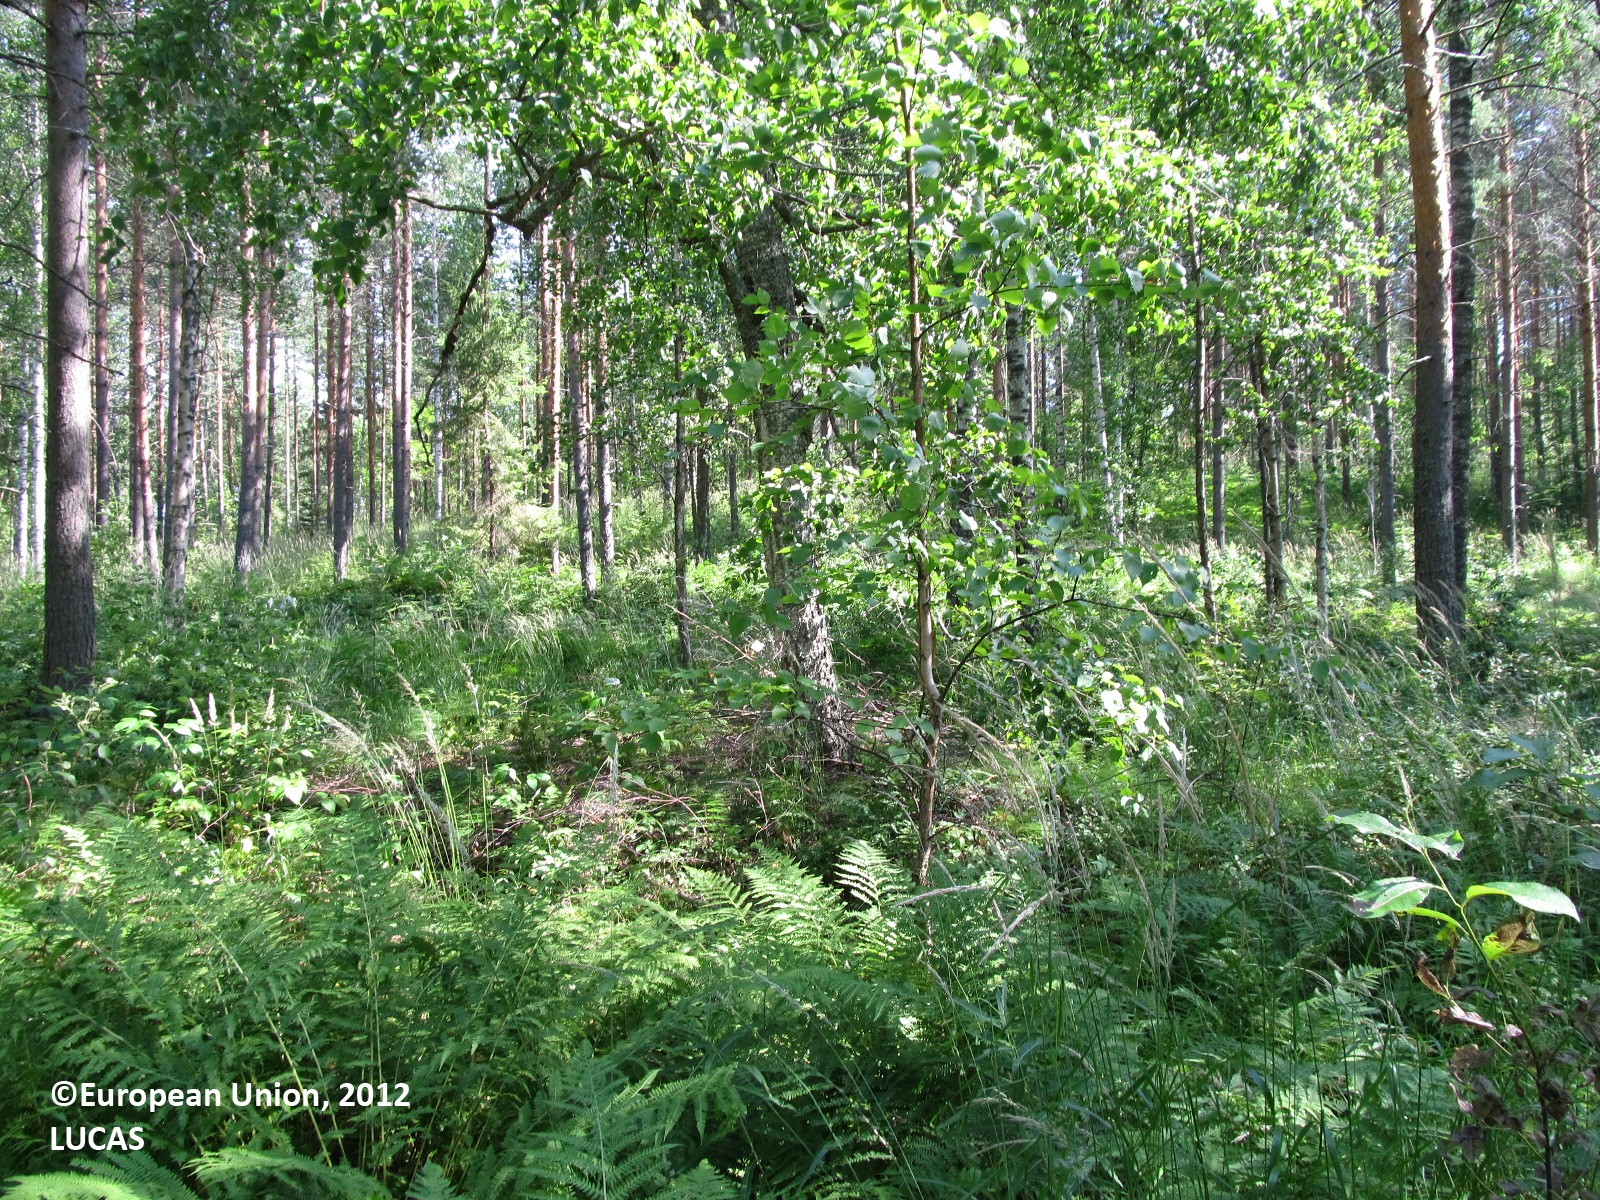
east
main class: Woodland
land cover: Pine dominated mixed woodland
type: boreal forest
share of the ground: 25 - 50 %
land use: Forestry
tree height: > 5 m
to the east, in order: Pine dominated mixed woodland; Ditches and canals; Pine dominated mixed woodland; Tracks; Pine dominated mixed woodland; Ditches and canals; Paved roads, cycling and walking lanes; Pine dominated mixed woodland; Broadleaved woodland
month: August
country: FI
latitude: 62.0943
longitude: 28.6955
